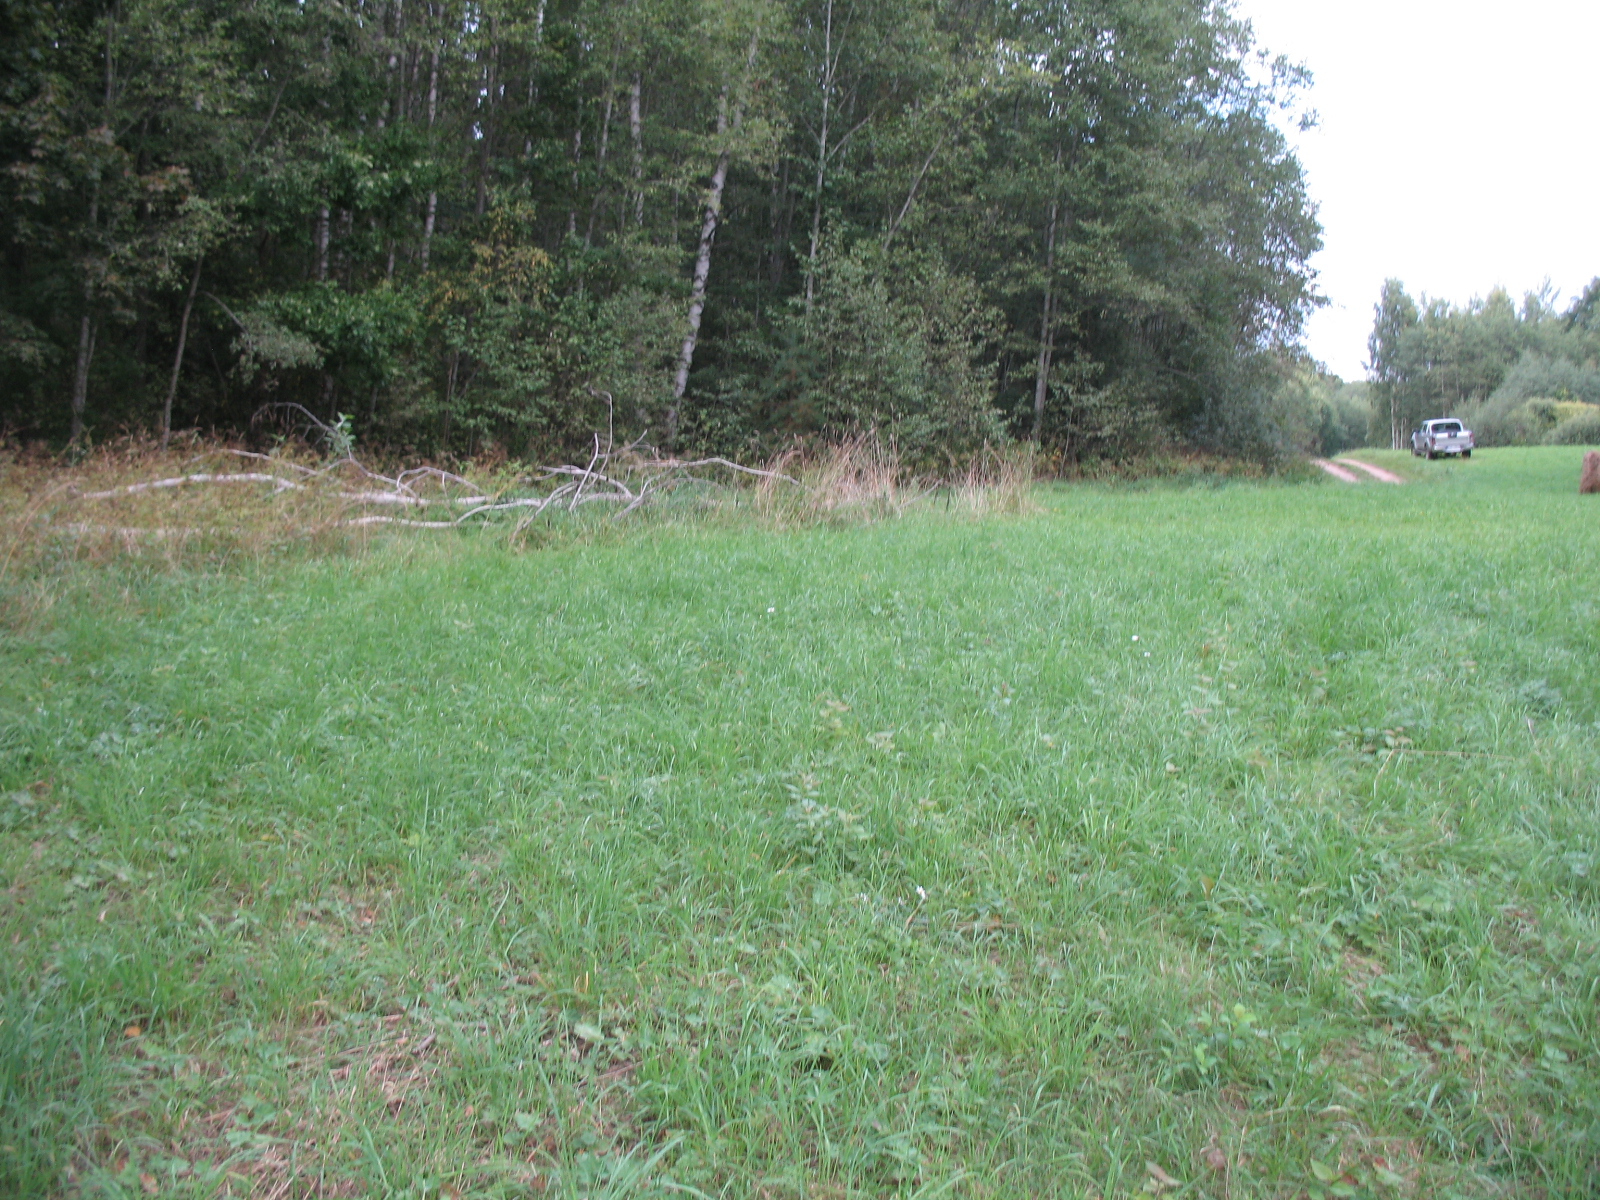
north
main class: Grassland
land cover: Grassland without tree/shrub cover
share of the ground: > 75 %
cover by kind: herbaceous plants 95 %, unconsolidated bare surface 5 %
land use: Agriculture (excluding fallow land and kitchen gardens)
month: September
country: LV
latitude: 56.1063
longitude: 26.0385
